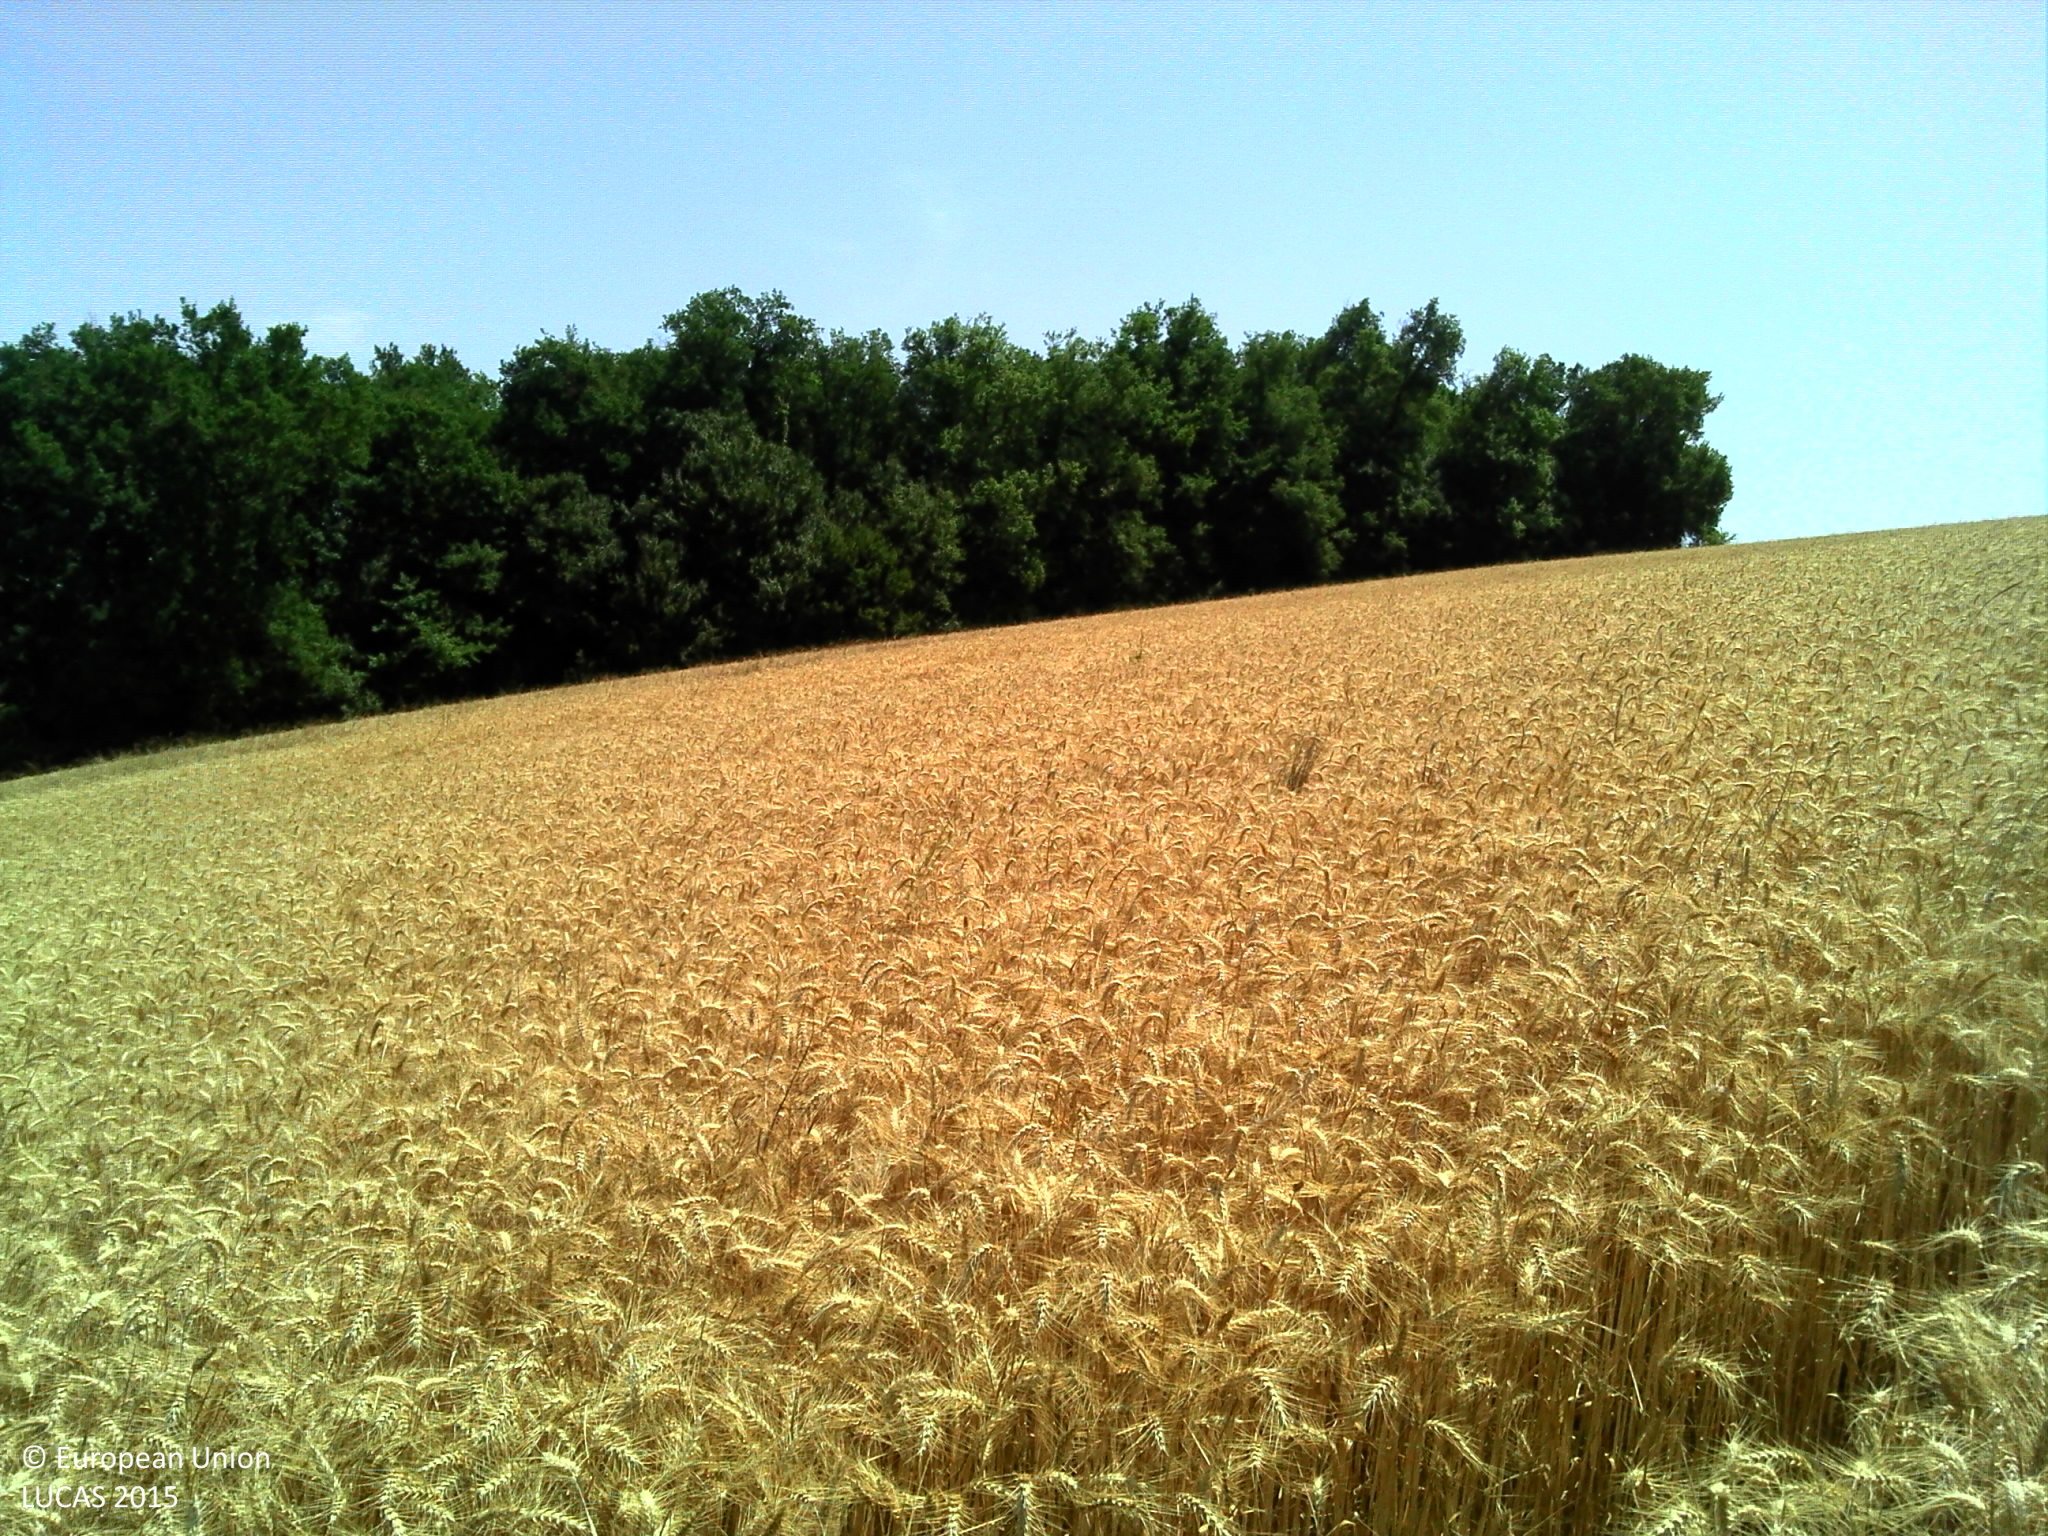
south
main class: Cropland
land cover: Durum wheat
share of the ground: > 75 %
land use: Agriculture (excluding fallow land and kitchen gardens)
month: July
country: FR
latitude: 43.5039
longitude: 0.9844
